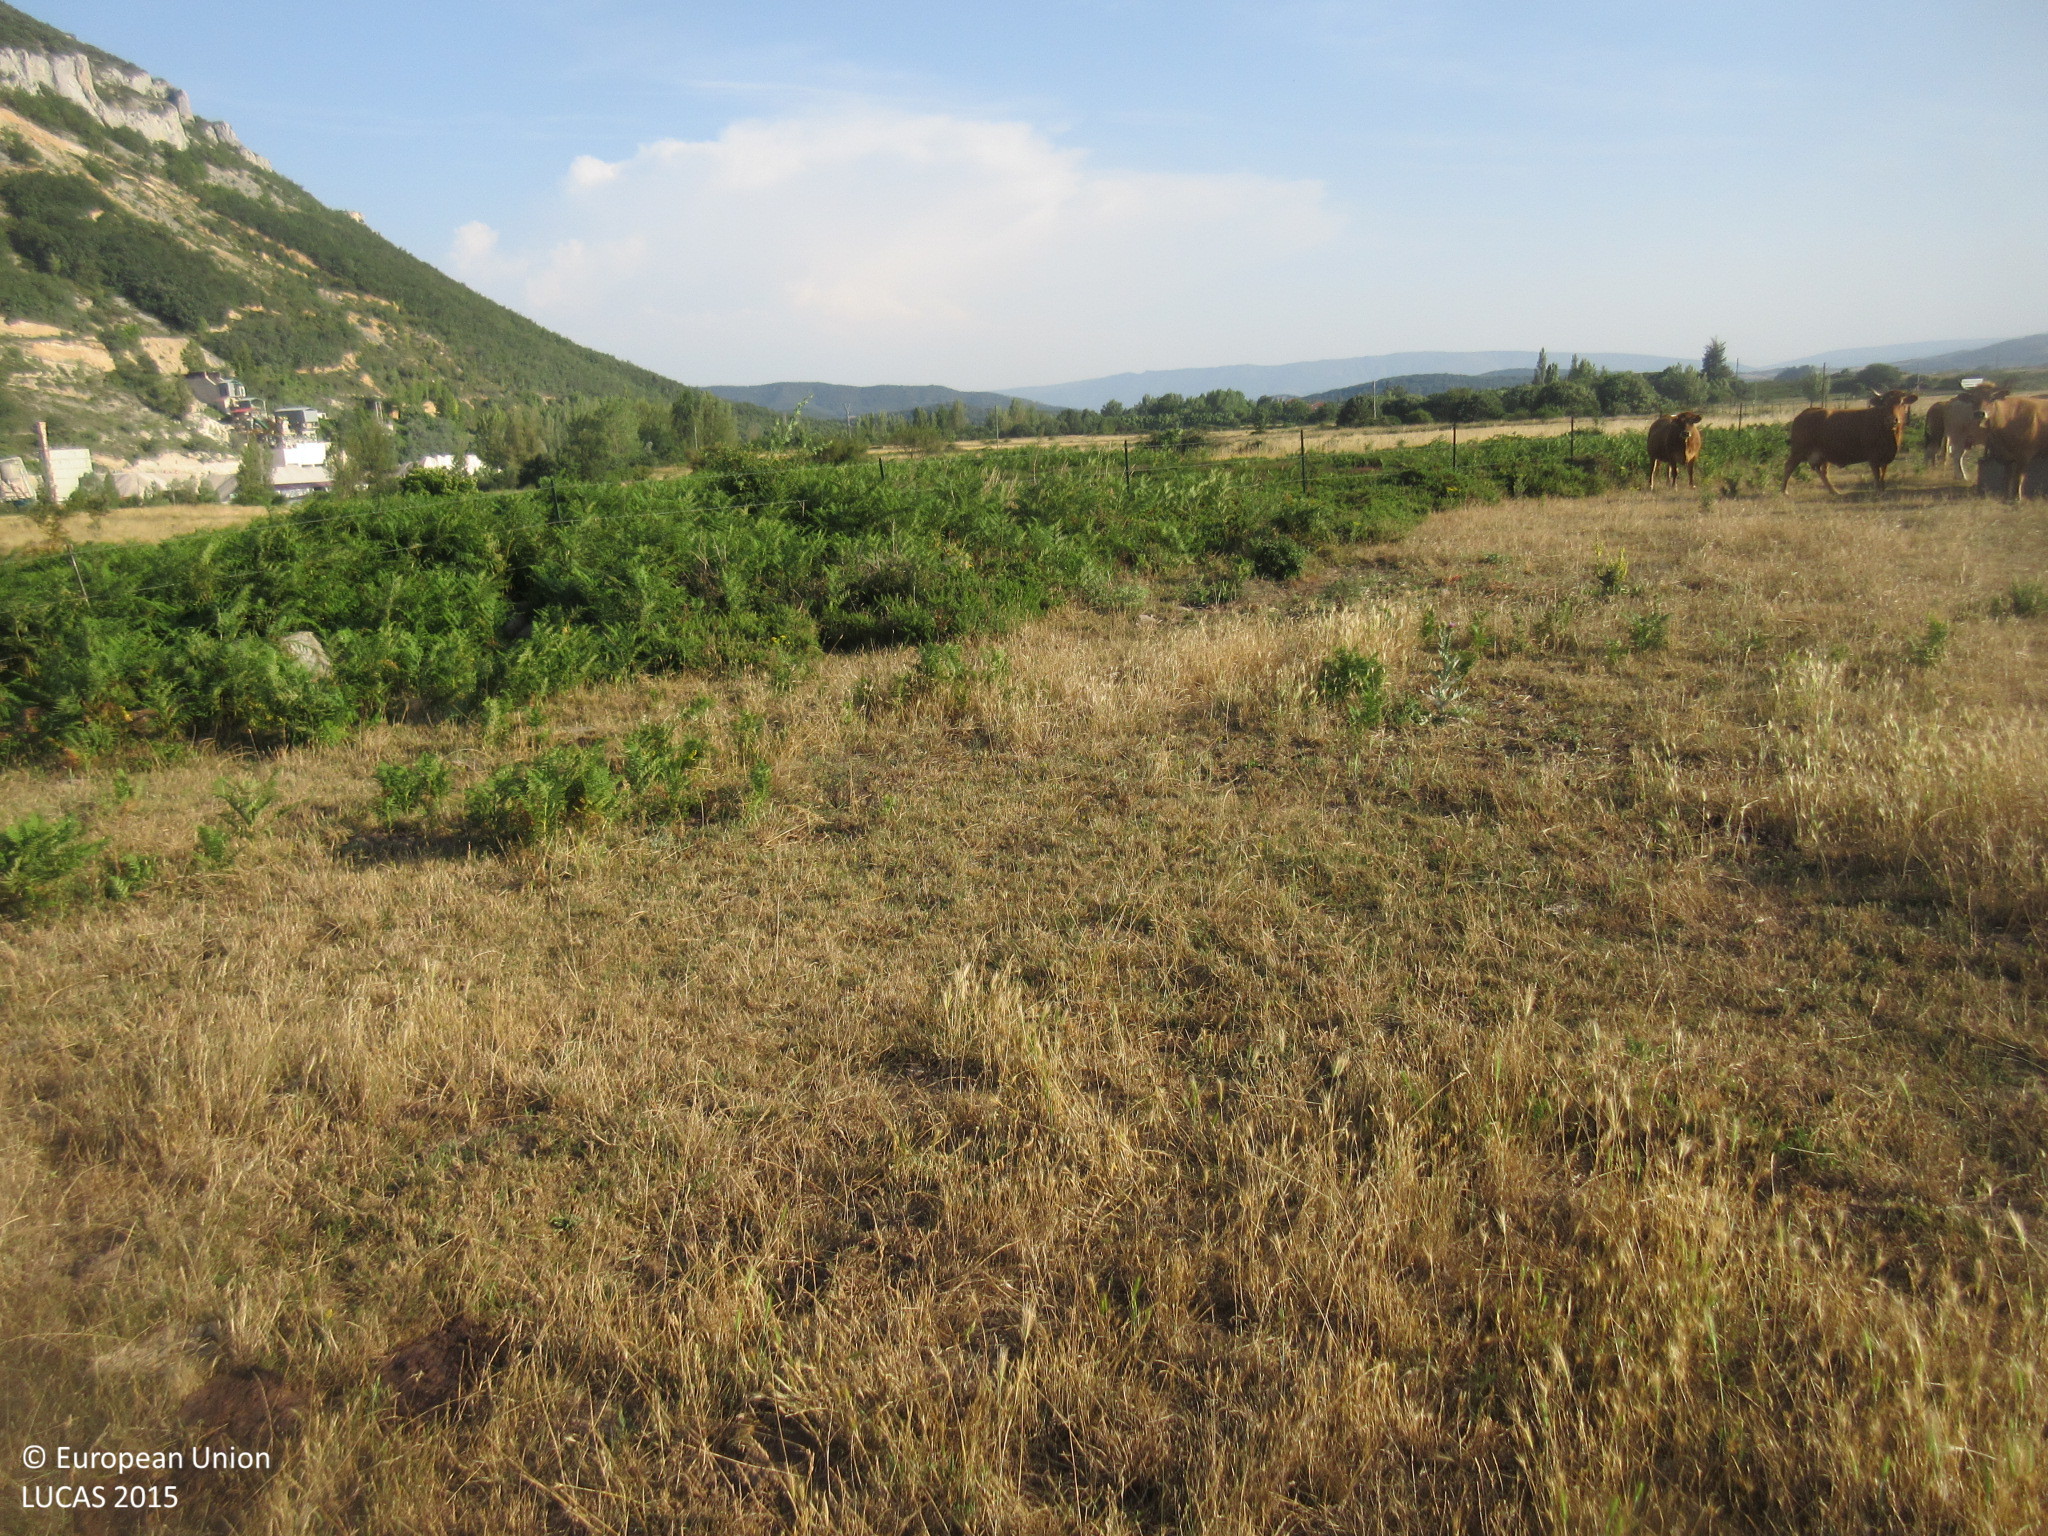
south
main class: Grassland
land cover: Grassland without tree/shrub cover
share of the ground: > 75 %
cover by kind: herbaceous plants 100 %
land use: Agriculture (excluding fallow land and kitchen gardens)
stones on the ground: < 10 %
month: July
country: ES
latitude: 43.0459
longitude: -3.4821
